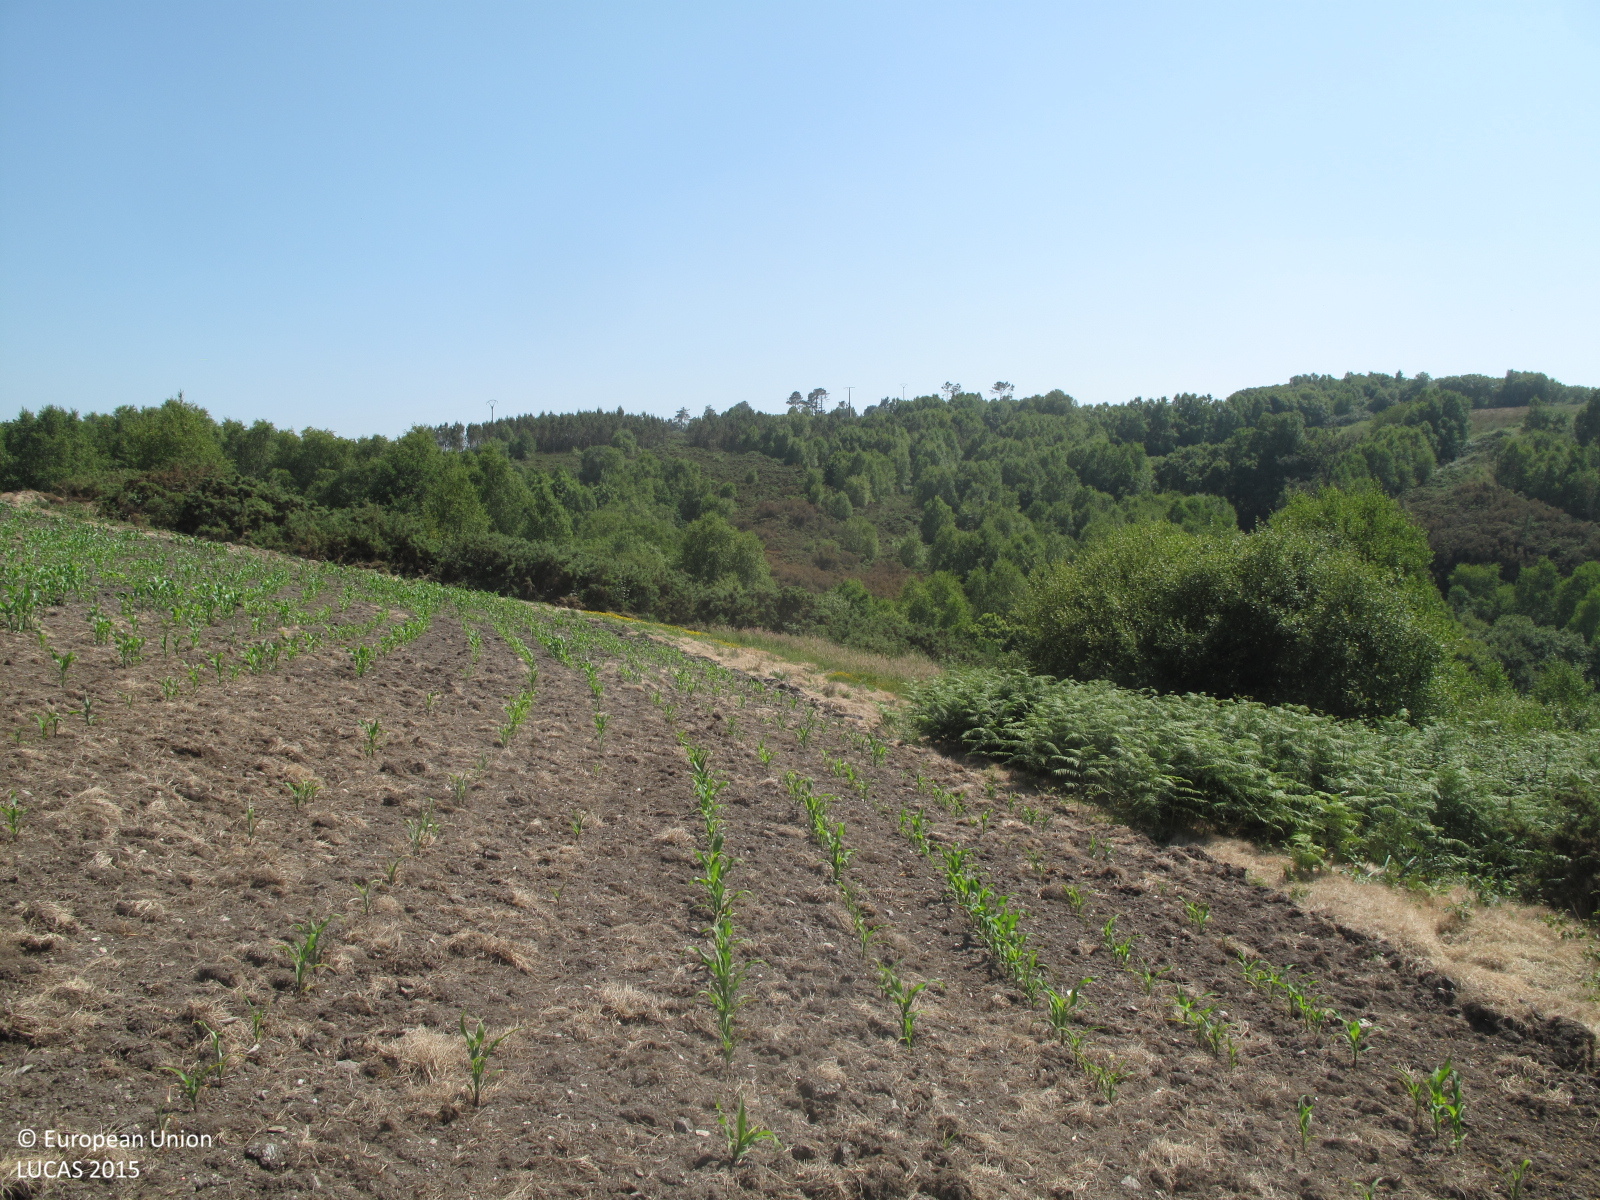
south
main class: Shrubland
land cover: Shrubland without tree cover
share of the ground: 50 - 75 %
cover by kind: shrubs 70 %, herbaceous plants 30 %
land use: Abandoned areas
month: June
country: ES
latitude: 43.2685
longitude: -7.9440
